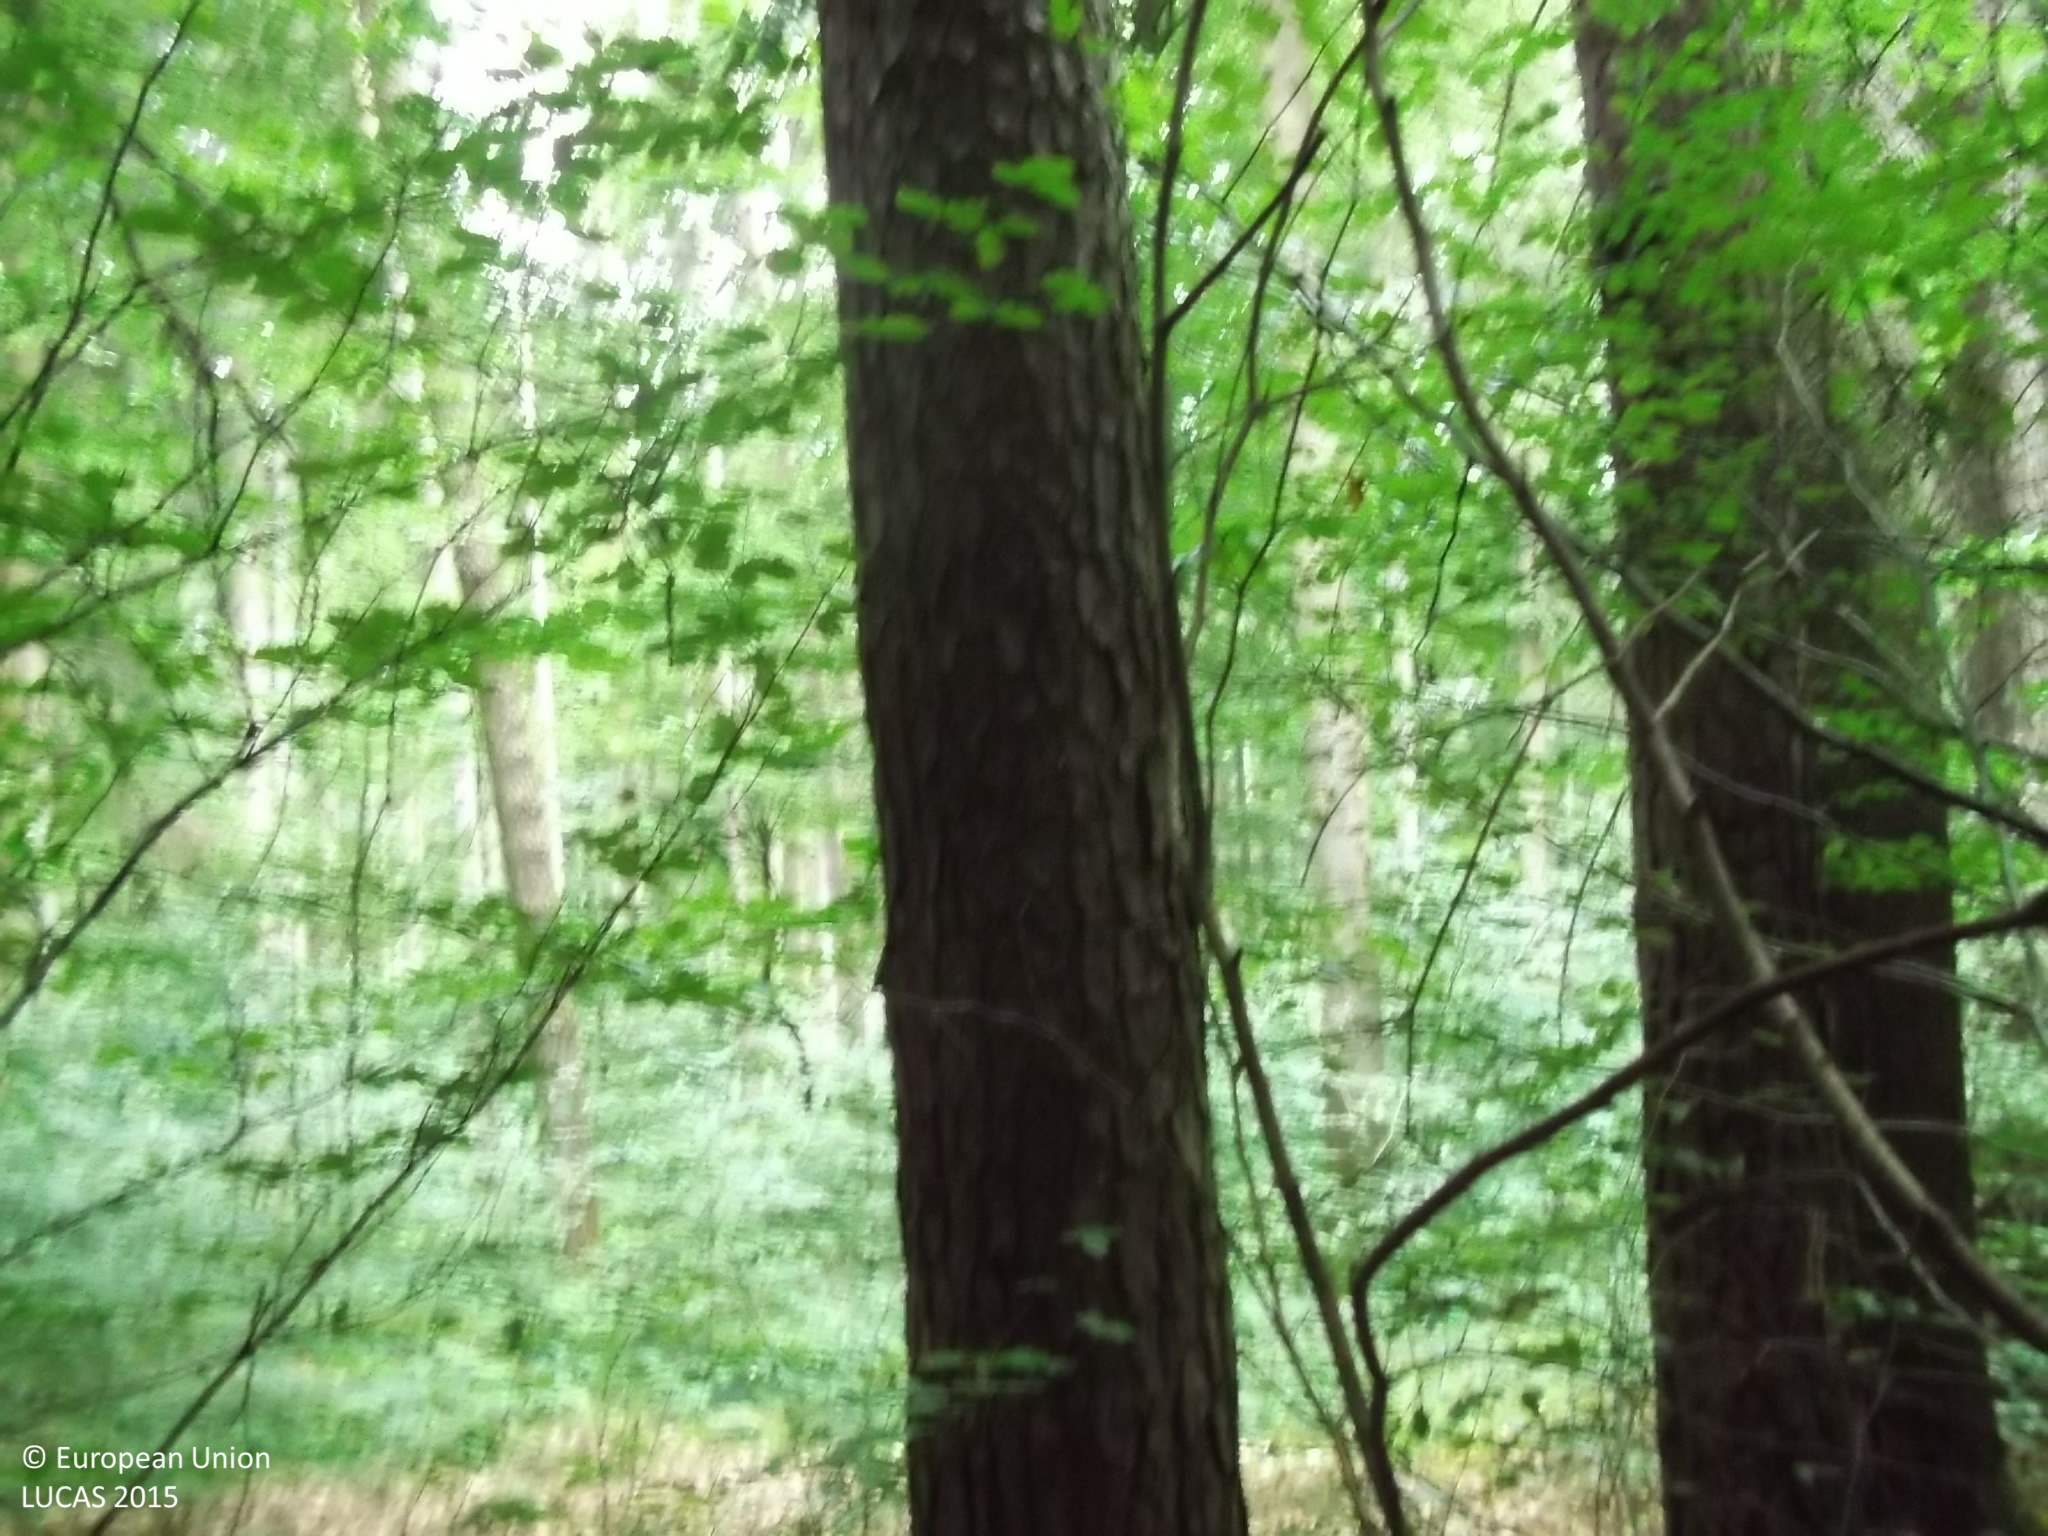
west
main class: Woodland
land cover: Other mixed woodland
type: hemiboreal forest and nemoral coniferous forest and mixed broadleaved-coniferous forest
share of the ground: > 75 %
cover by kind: broadleaved forest trees 55 %, coniferous forest trees 40 %, shrubs 5 %
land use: Forestry
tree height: > 5 m
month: July
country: AT
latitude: 48.1165
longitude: 12.7795
